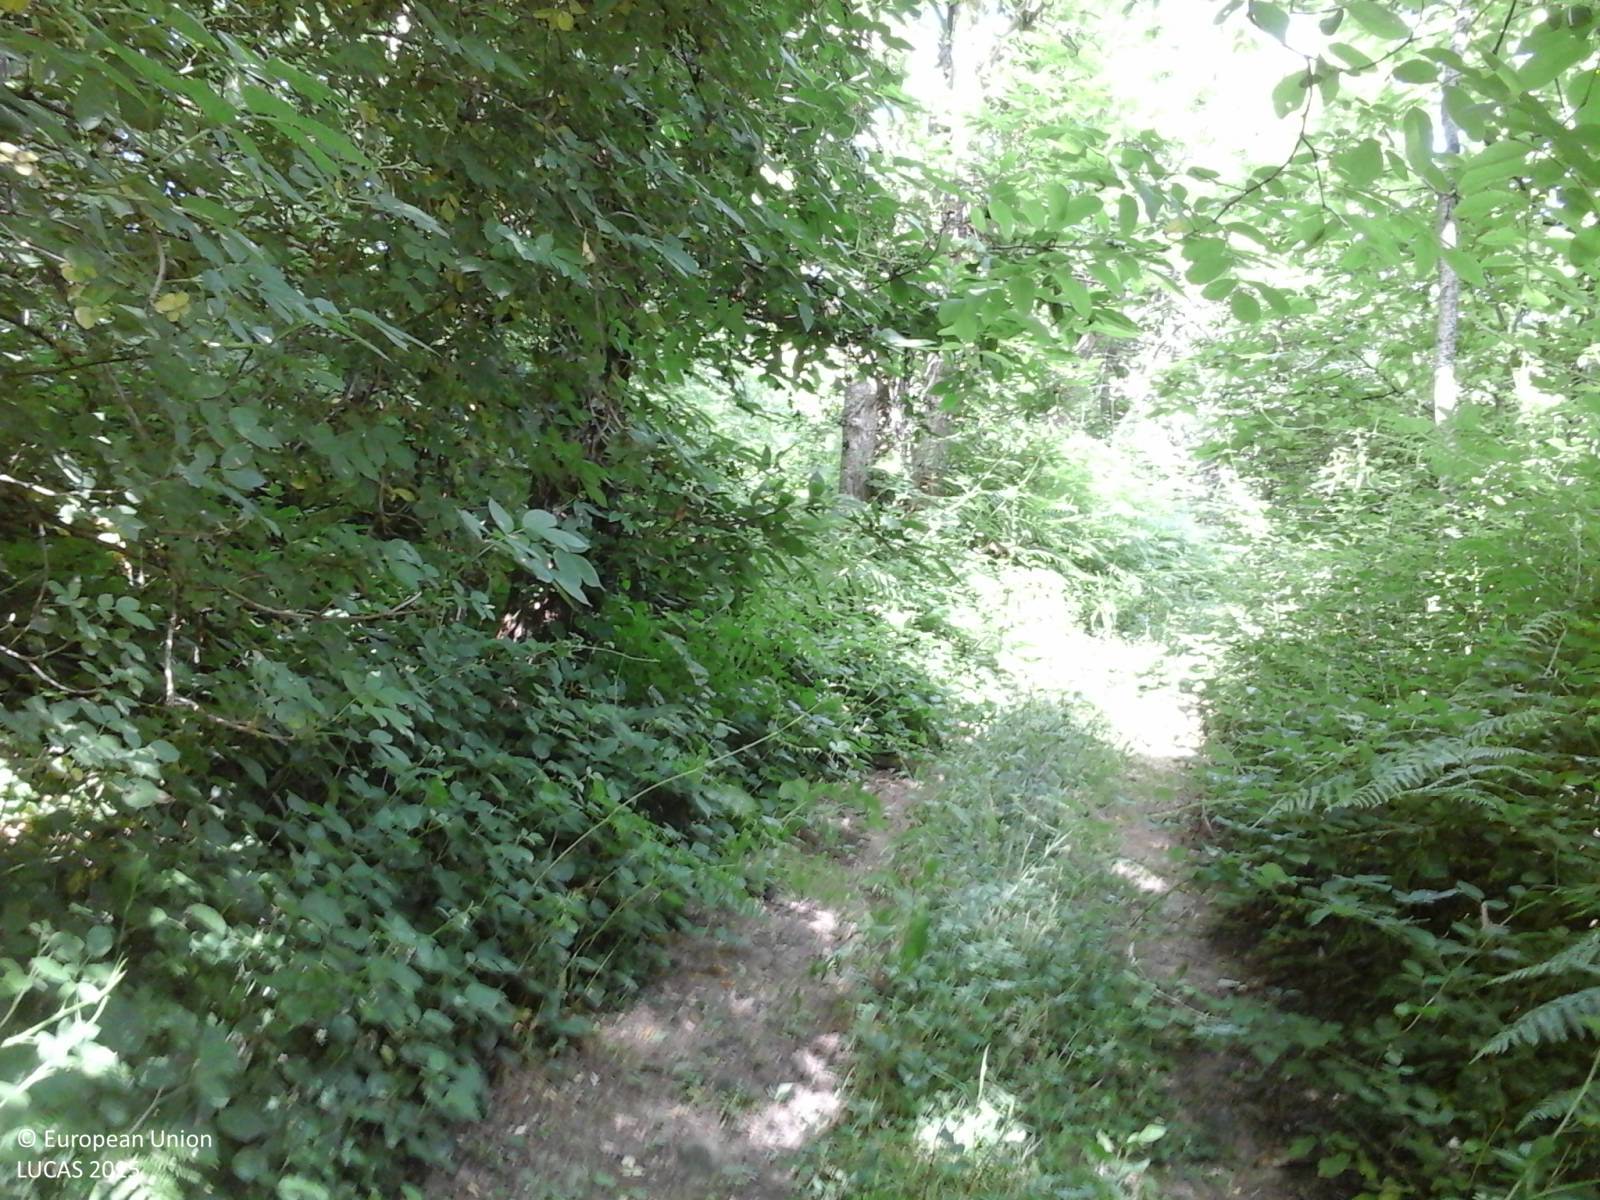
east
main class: Woodland
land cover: Broadleaved woodland
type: thermophilous deciduous forest
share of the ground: > 75 %
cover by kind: broadleaved forest trees 100 %
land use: Forestry
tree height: > 5 m
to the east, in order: Broadleaved woodland
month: June
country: IT
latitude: 44.1699
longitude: 10.2370
